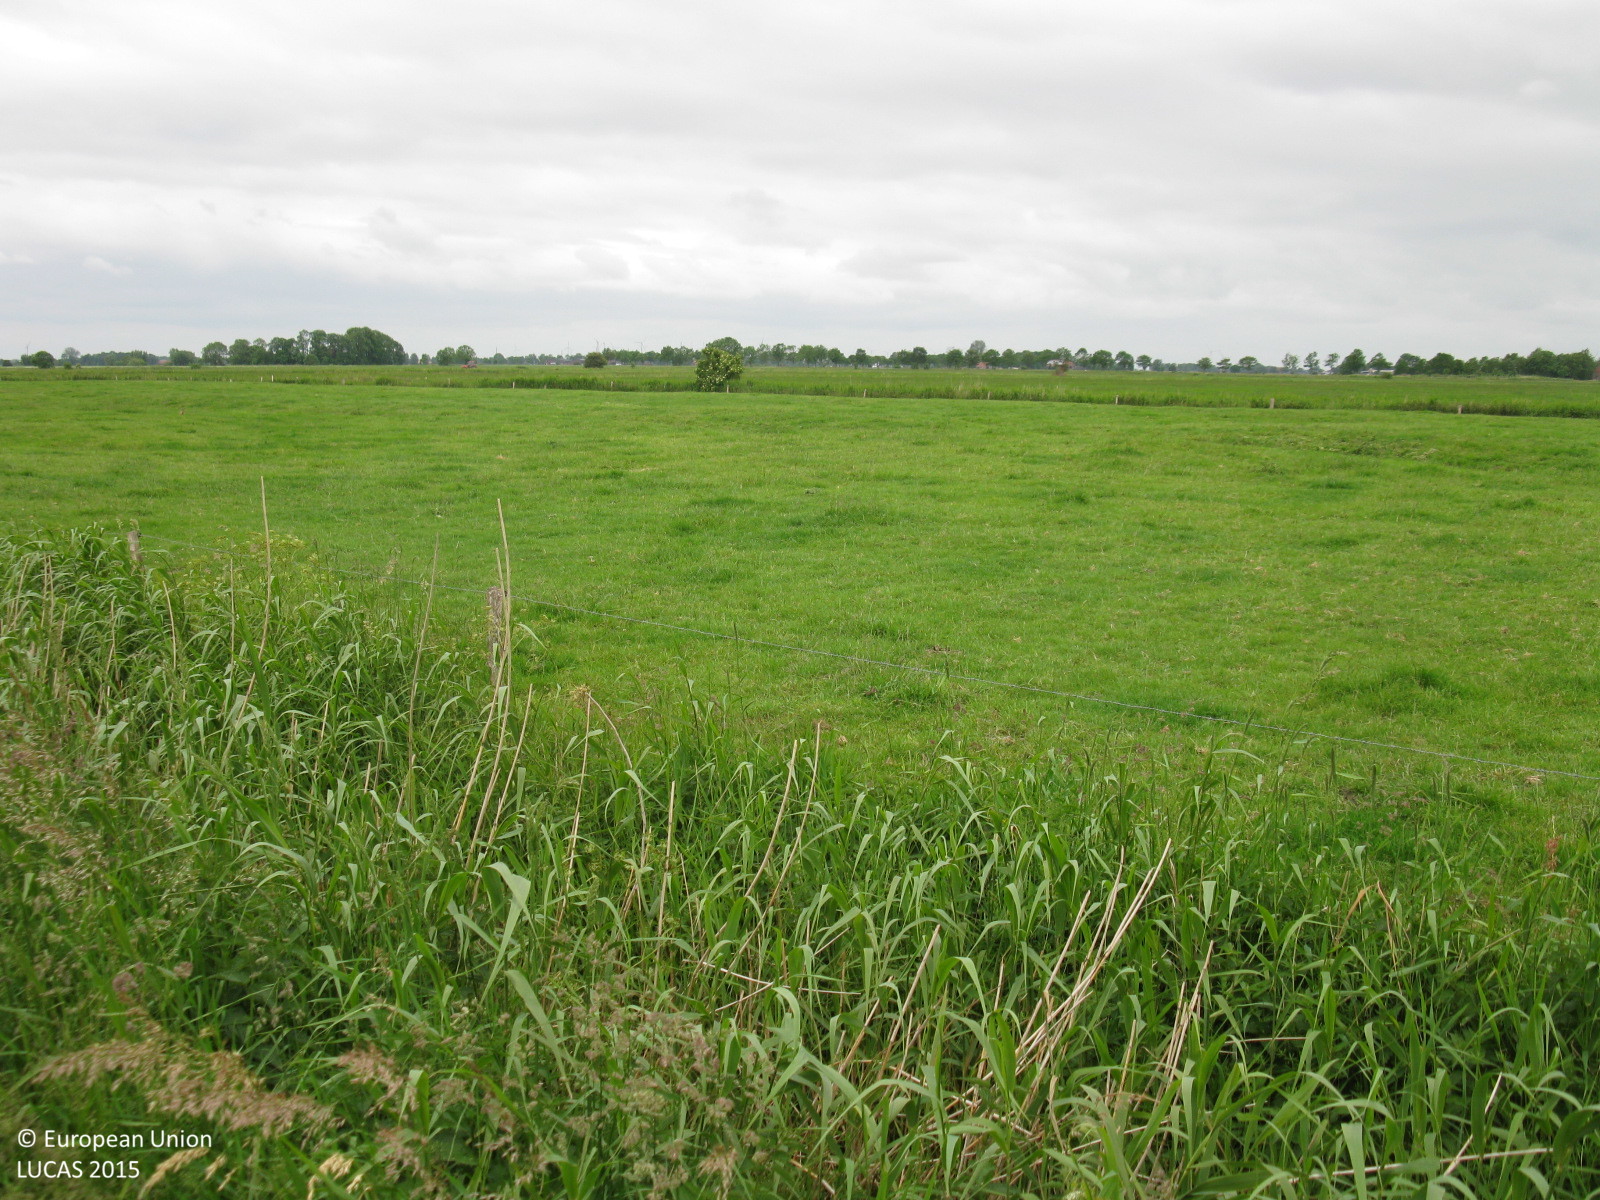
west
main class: Grassland
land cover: Grassland without tree/shrub cover
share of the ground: > 75 %
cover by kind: herbaceous plants 100 %
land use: Agriculture (excluding fallow land and kitchen gardens)
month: June
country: DE
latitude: 53.6175
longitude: 7.8995
